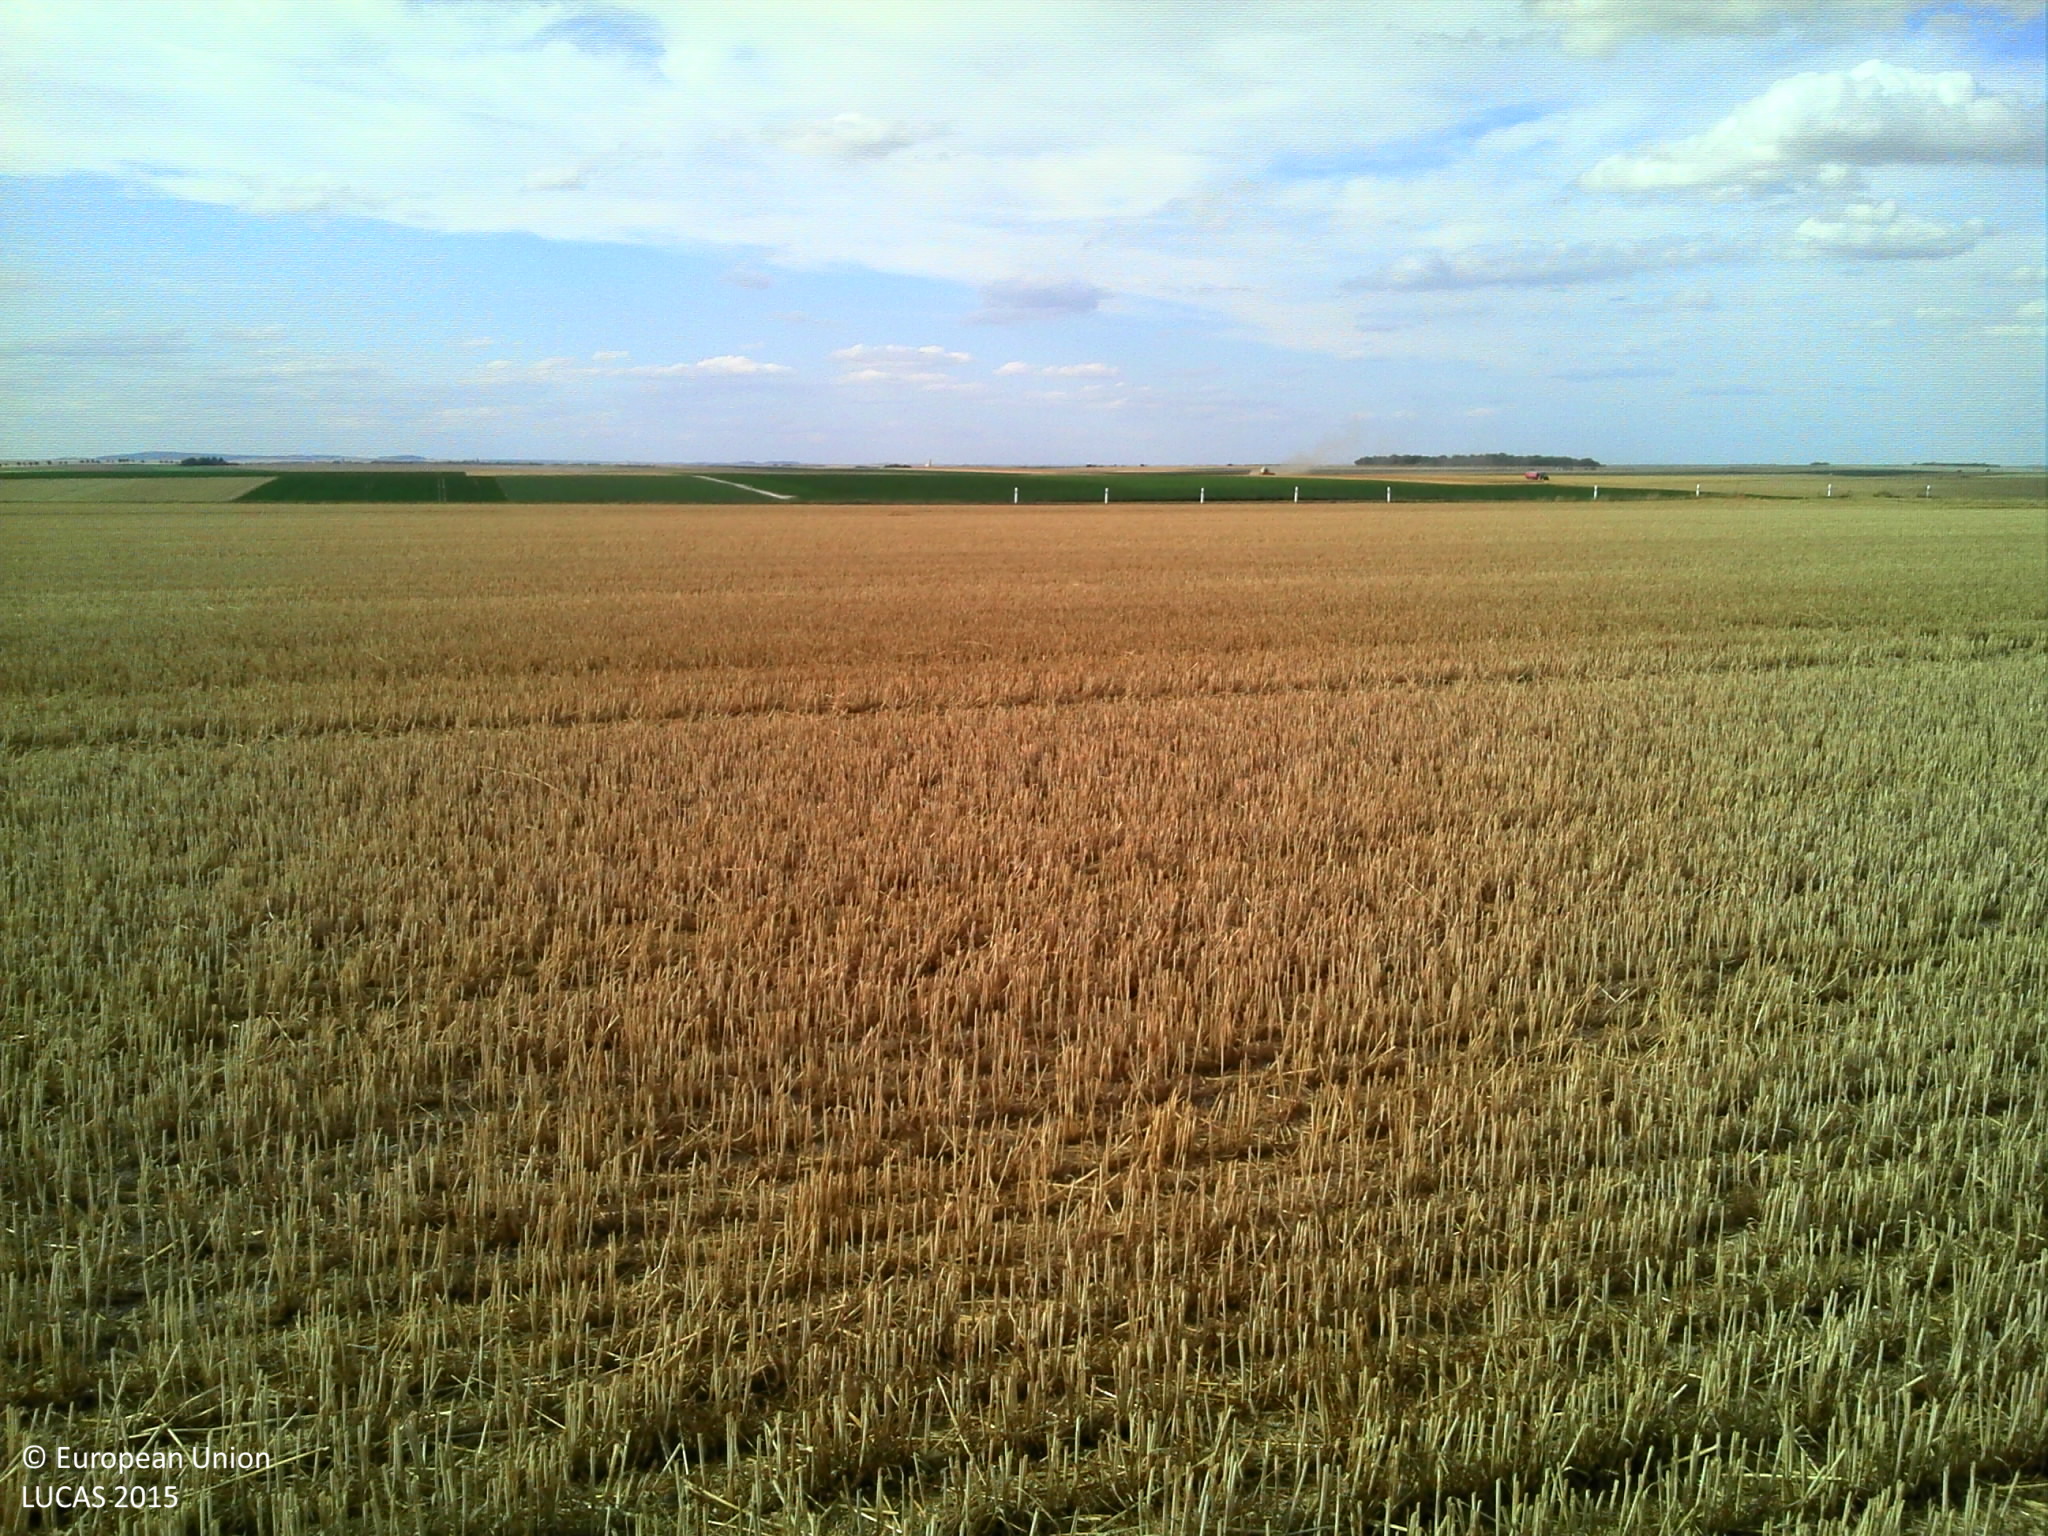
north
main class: Cropland
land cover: Durum wheat
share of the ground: > 75 %
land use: Agriculture (excluding fallow land and kitchen gardens)
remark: Harvested field
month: July
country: FR
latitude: 49.2920
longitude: 4.0966
